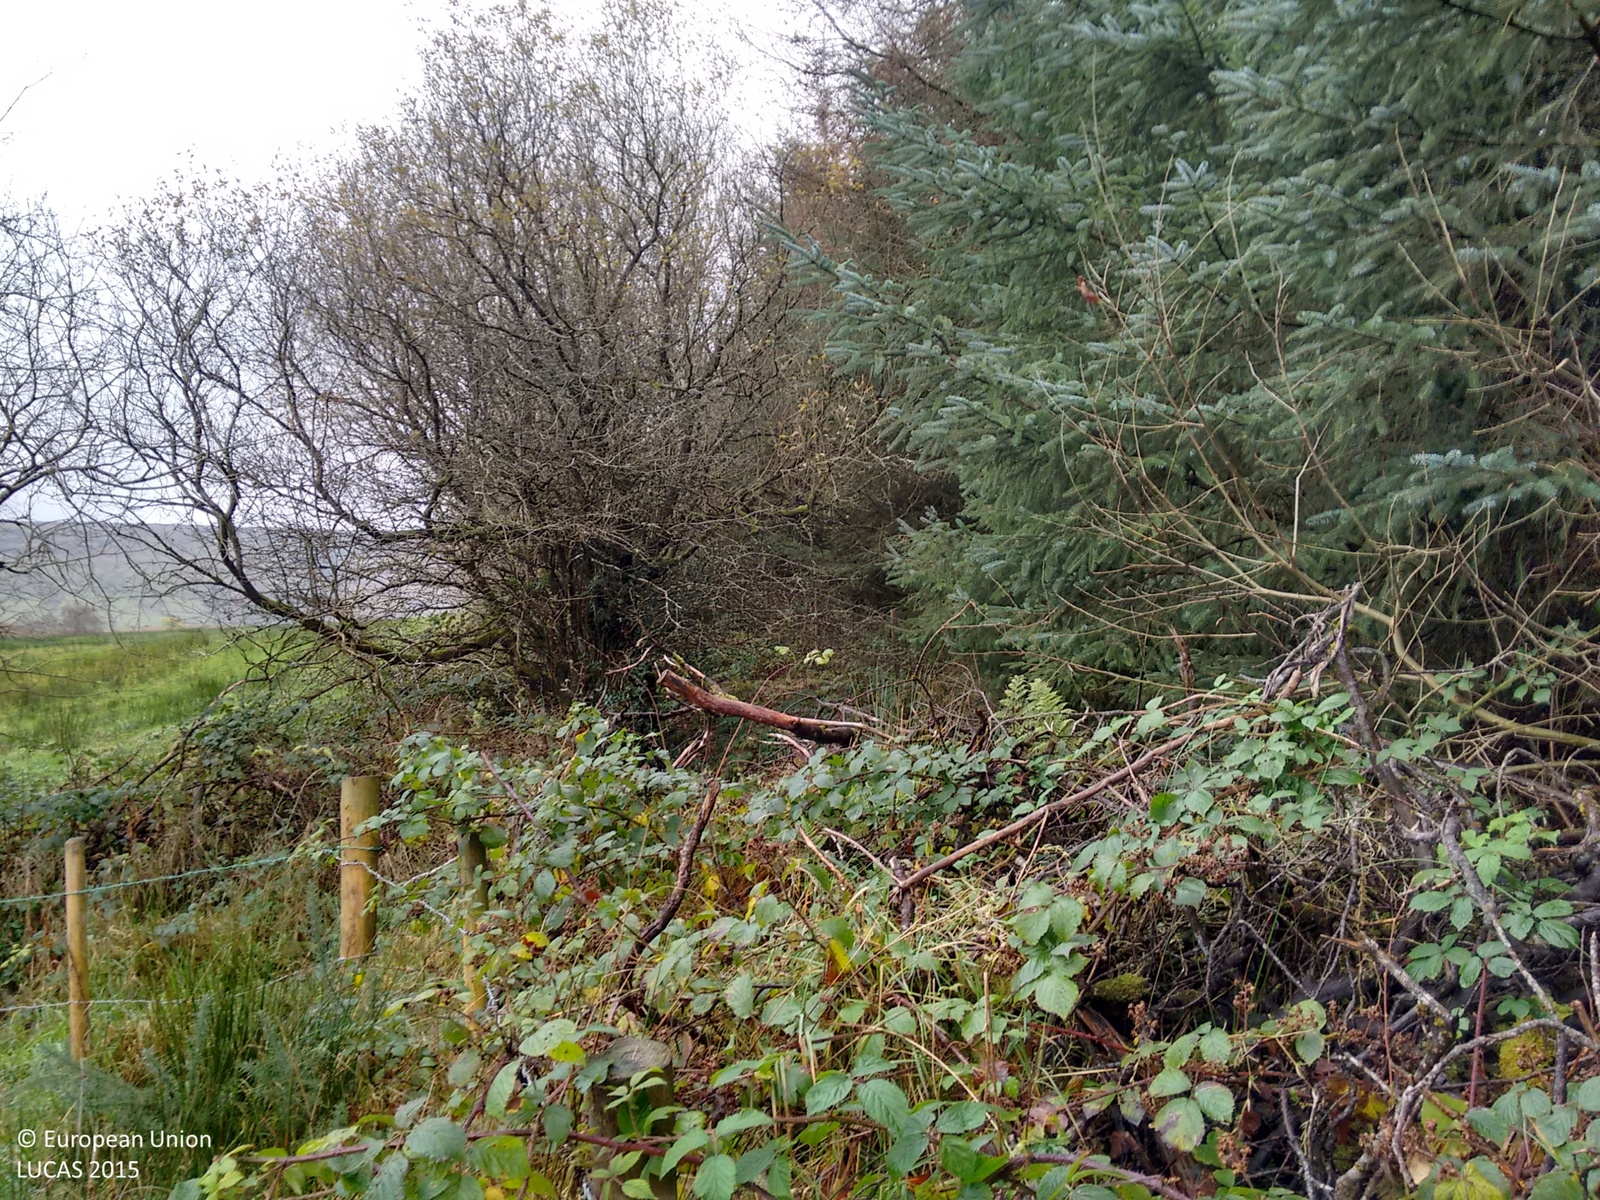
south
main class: Grassland
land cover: Grassland without tree/shrub cover
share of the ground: > 75 %
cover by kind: herbaceous plants 100 %
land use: Agriculture (excluding fallow land and kitchen gardens)
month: December
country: IE
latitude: 54.2911
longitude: -8.1060
